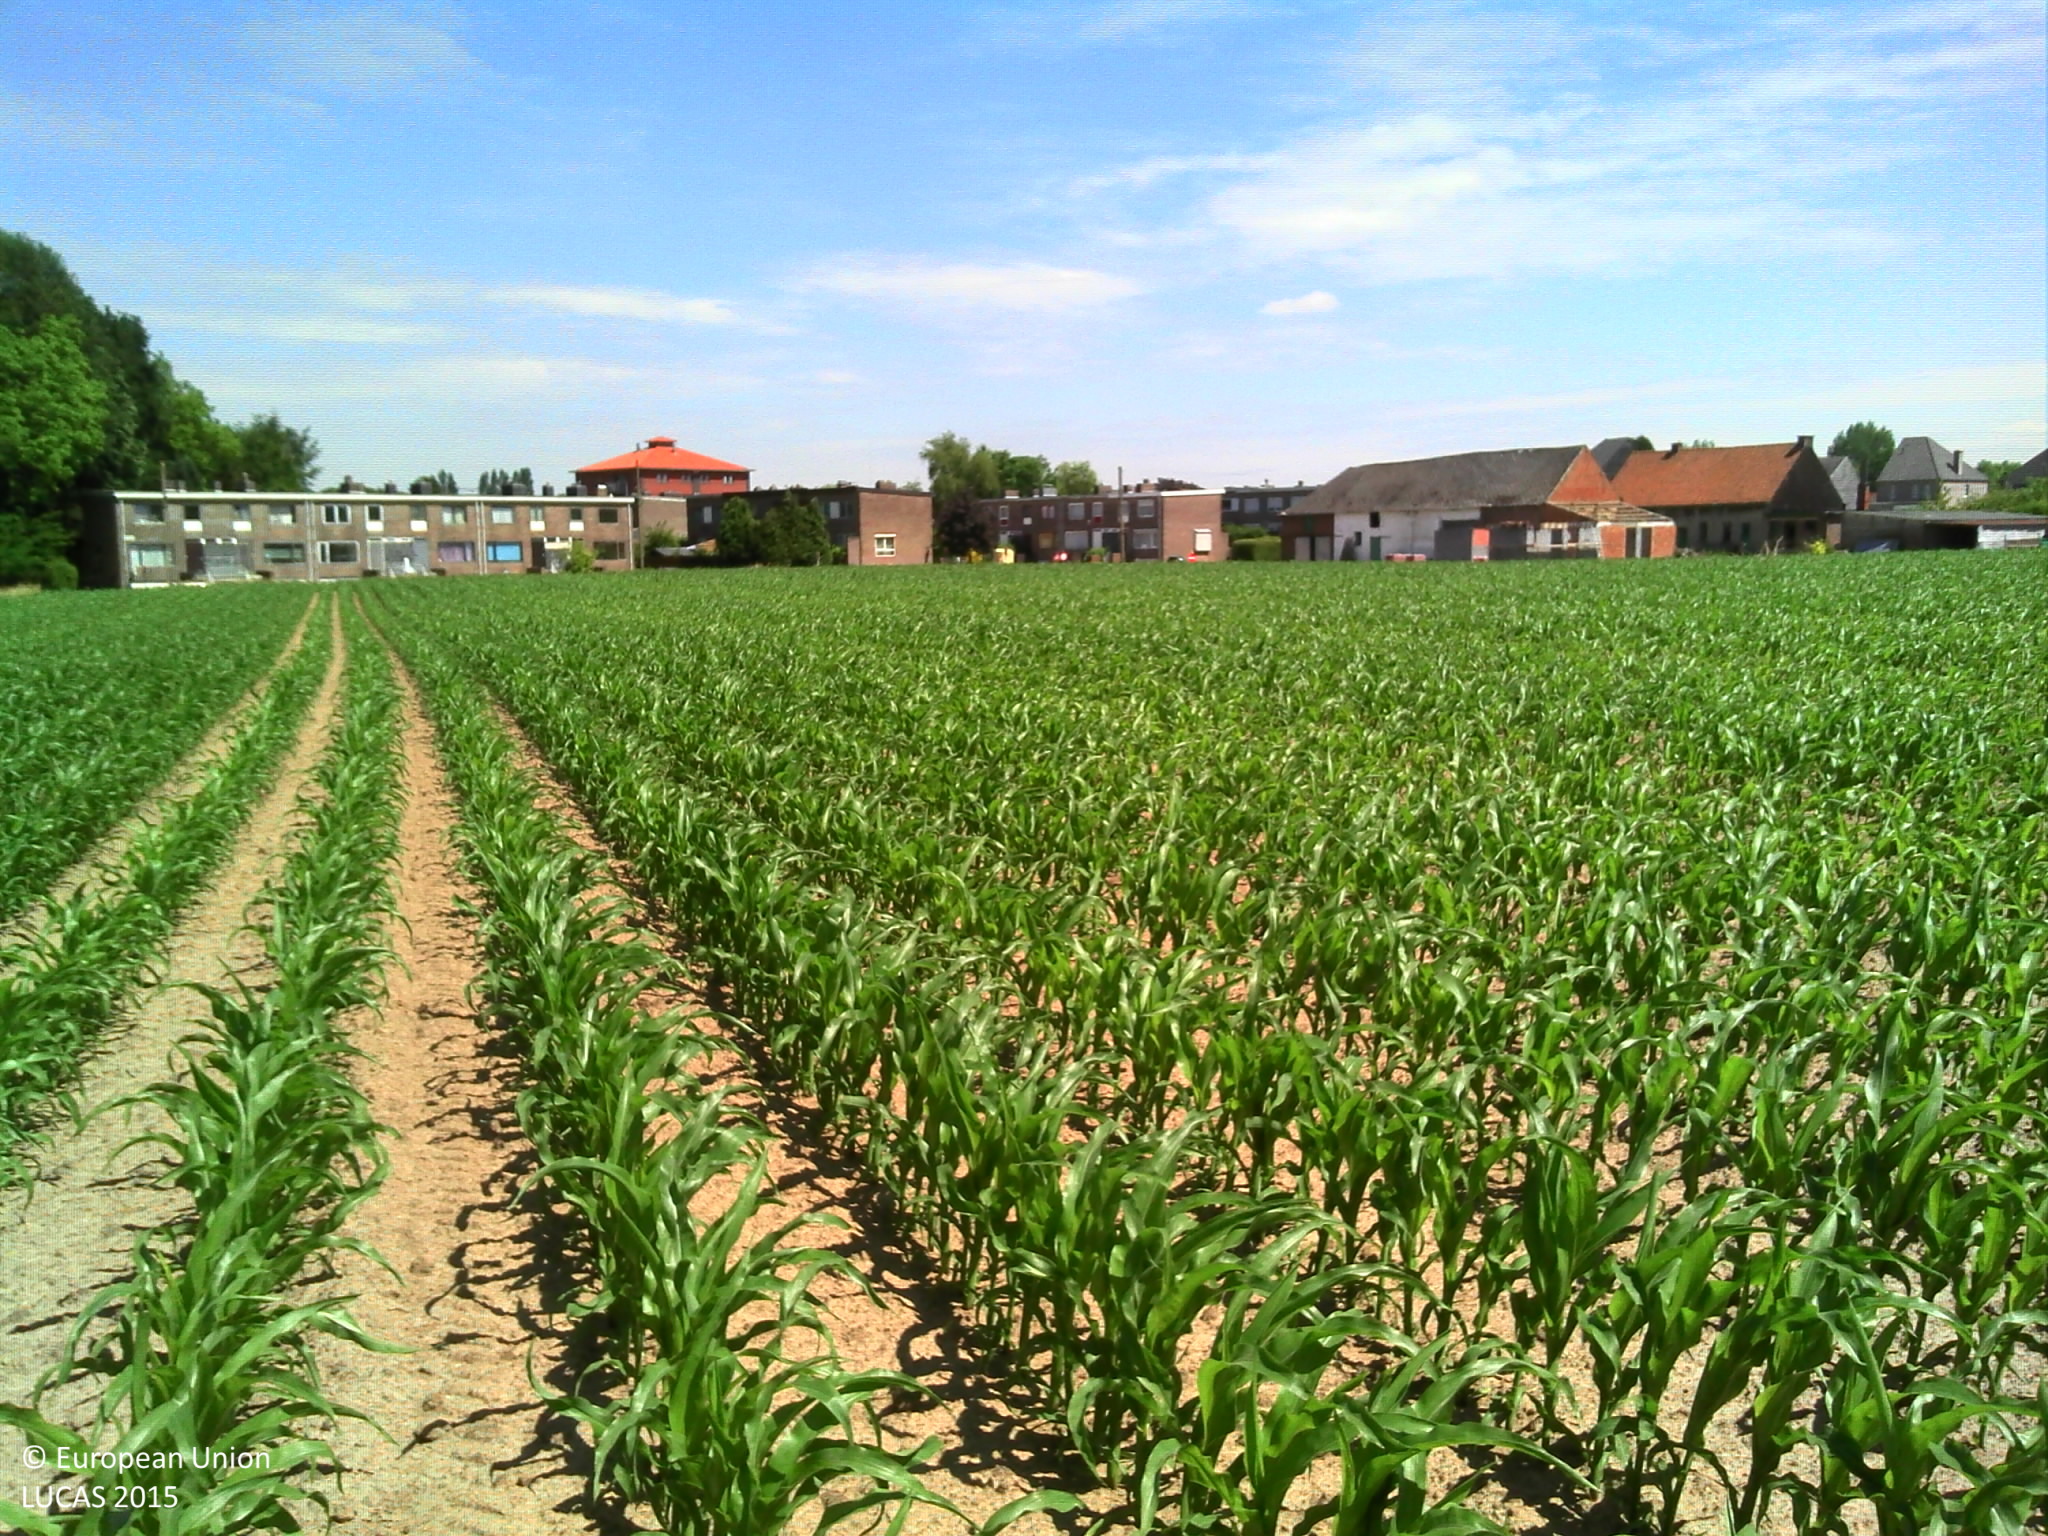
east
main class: Cropland
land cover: Maize
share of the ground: > 75 %
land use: Agriculture (excluding fallow land and kitchen gardens)
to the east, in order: Maize; Artificial constructions in urban areas
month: June
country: BE
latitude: 50.7425
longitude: 3.5730
